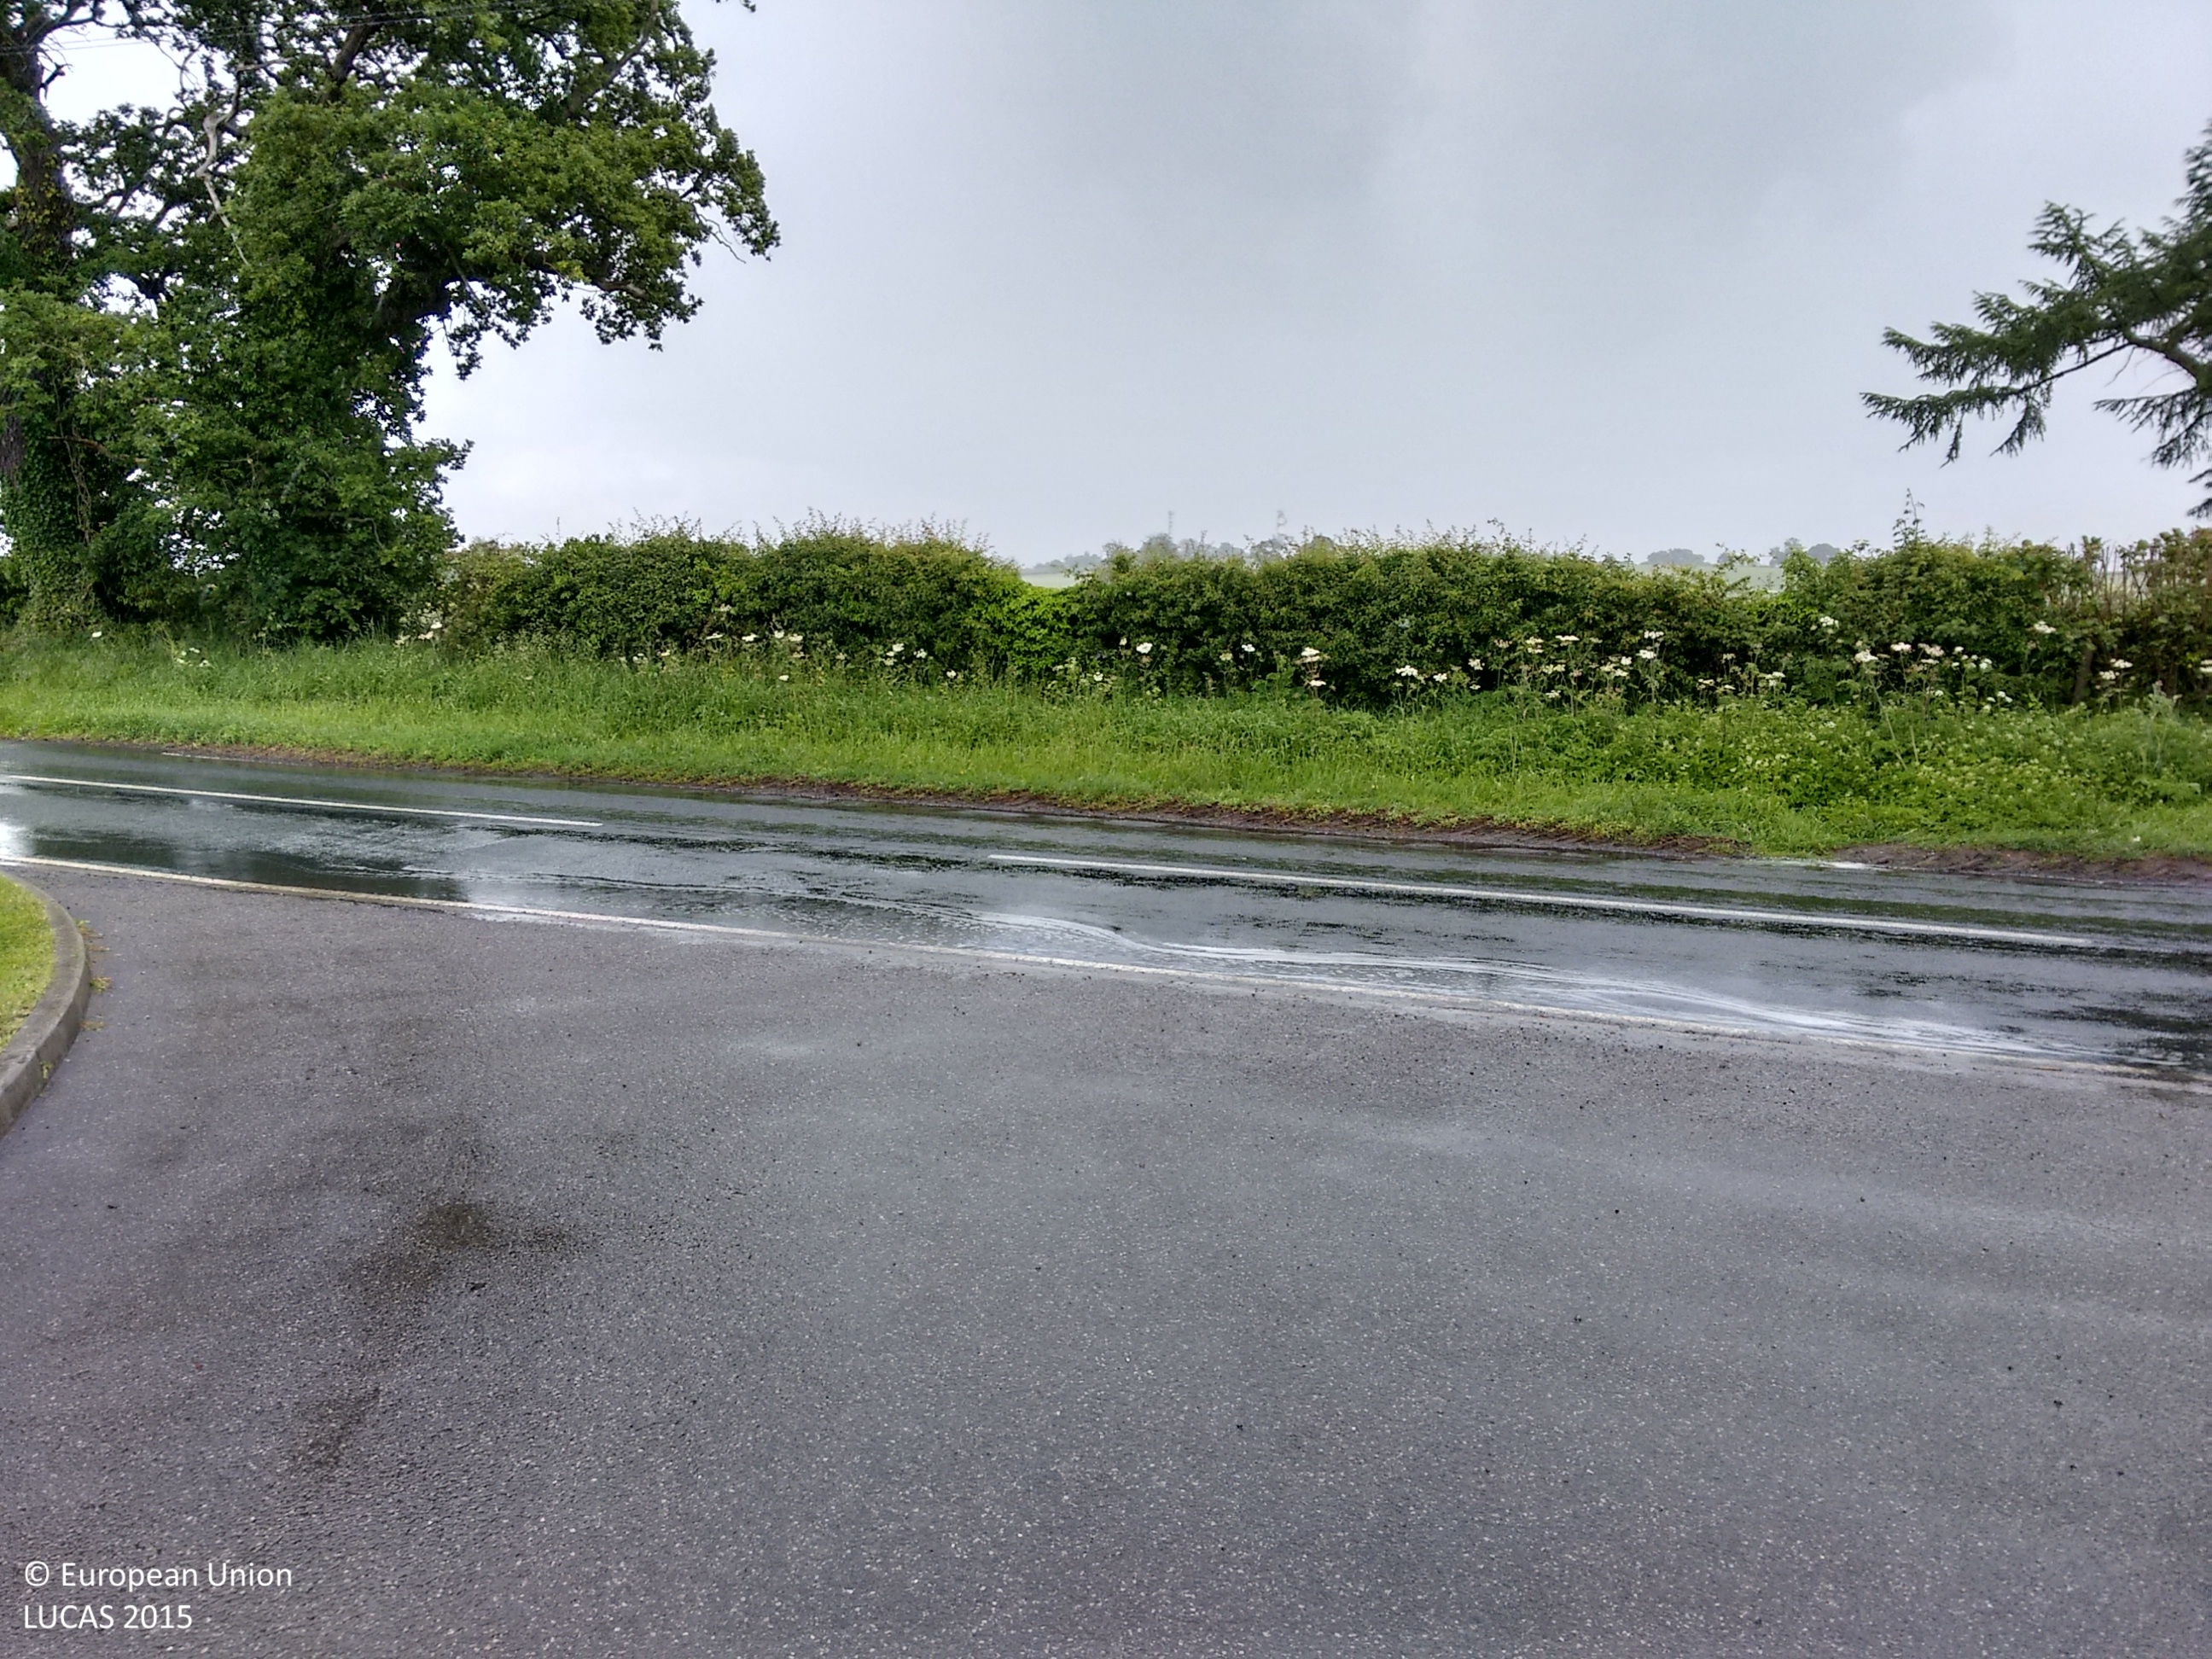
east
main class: Woodland
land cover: Broadleaved woodland
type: mesophytic deciduous forest
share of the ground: > 75 %
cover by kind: broadleaved forest trees 80 %, coniferous forest trees 20 %
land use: Semi-natural and natural areas not in use
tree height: > 5 m
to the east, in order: Broadleaved woodland; Grass margins; Broadleaved woodland; Grass margins; Permanent crops (only in case pi)
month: June
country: GB
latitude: 53.8702
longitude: -1.1006
